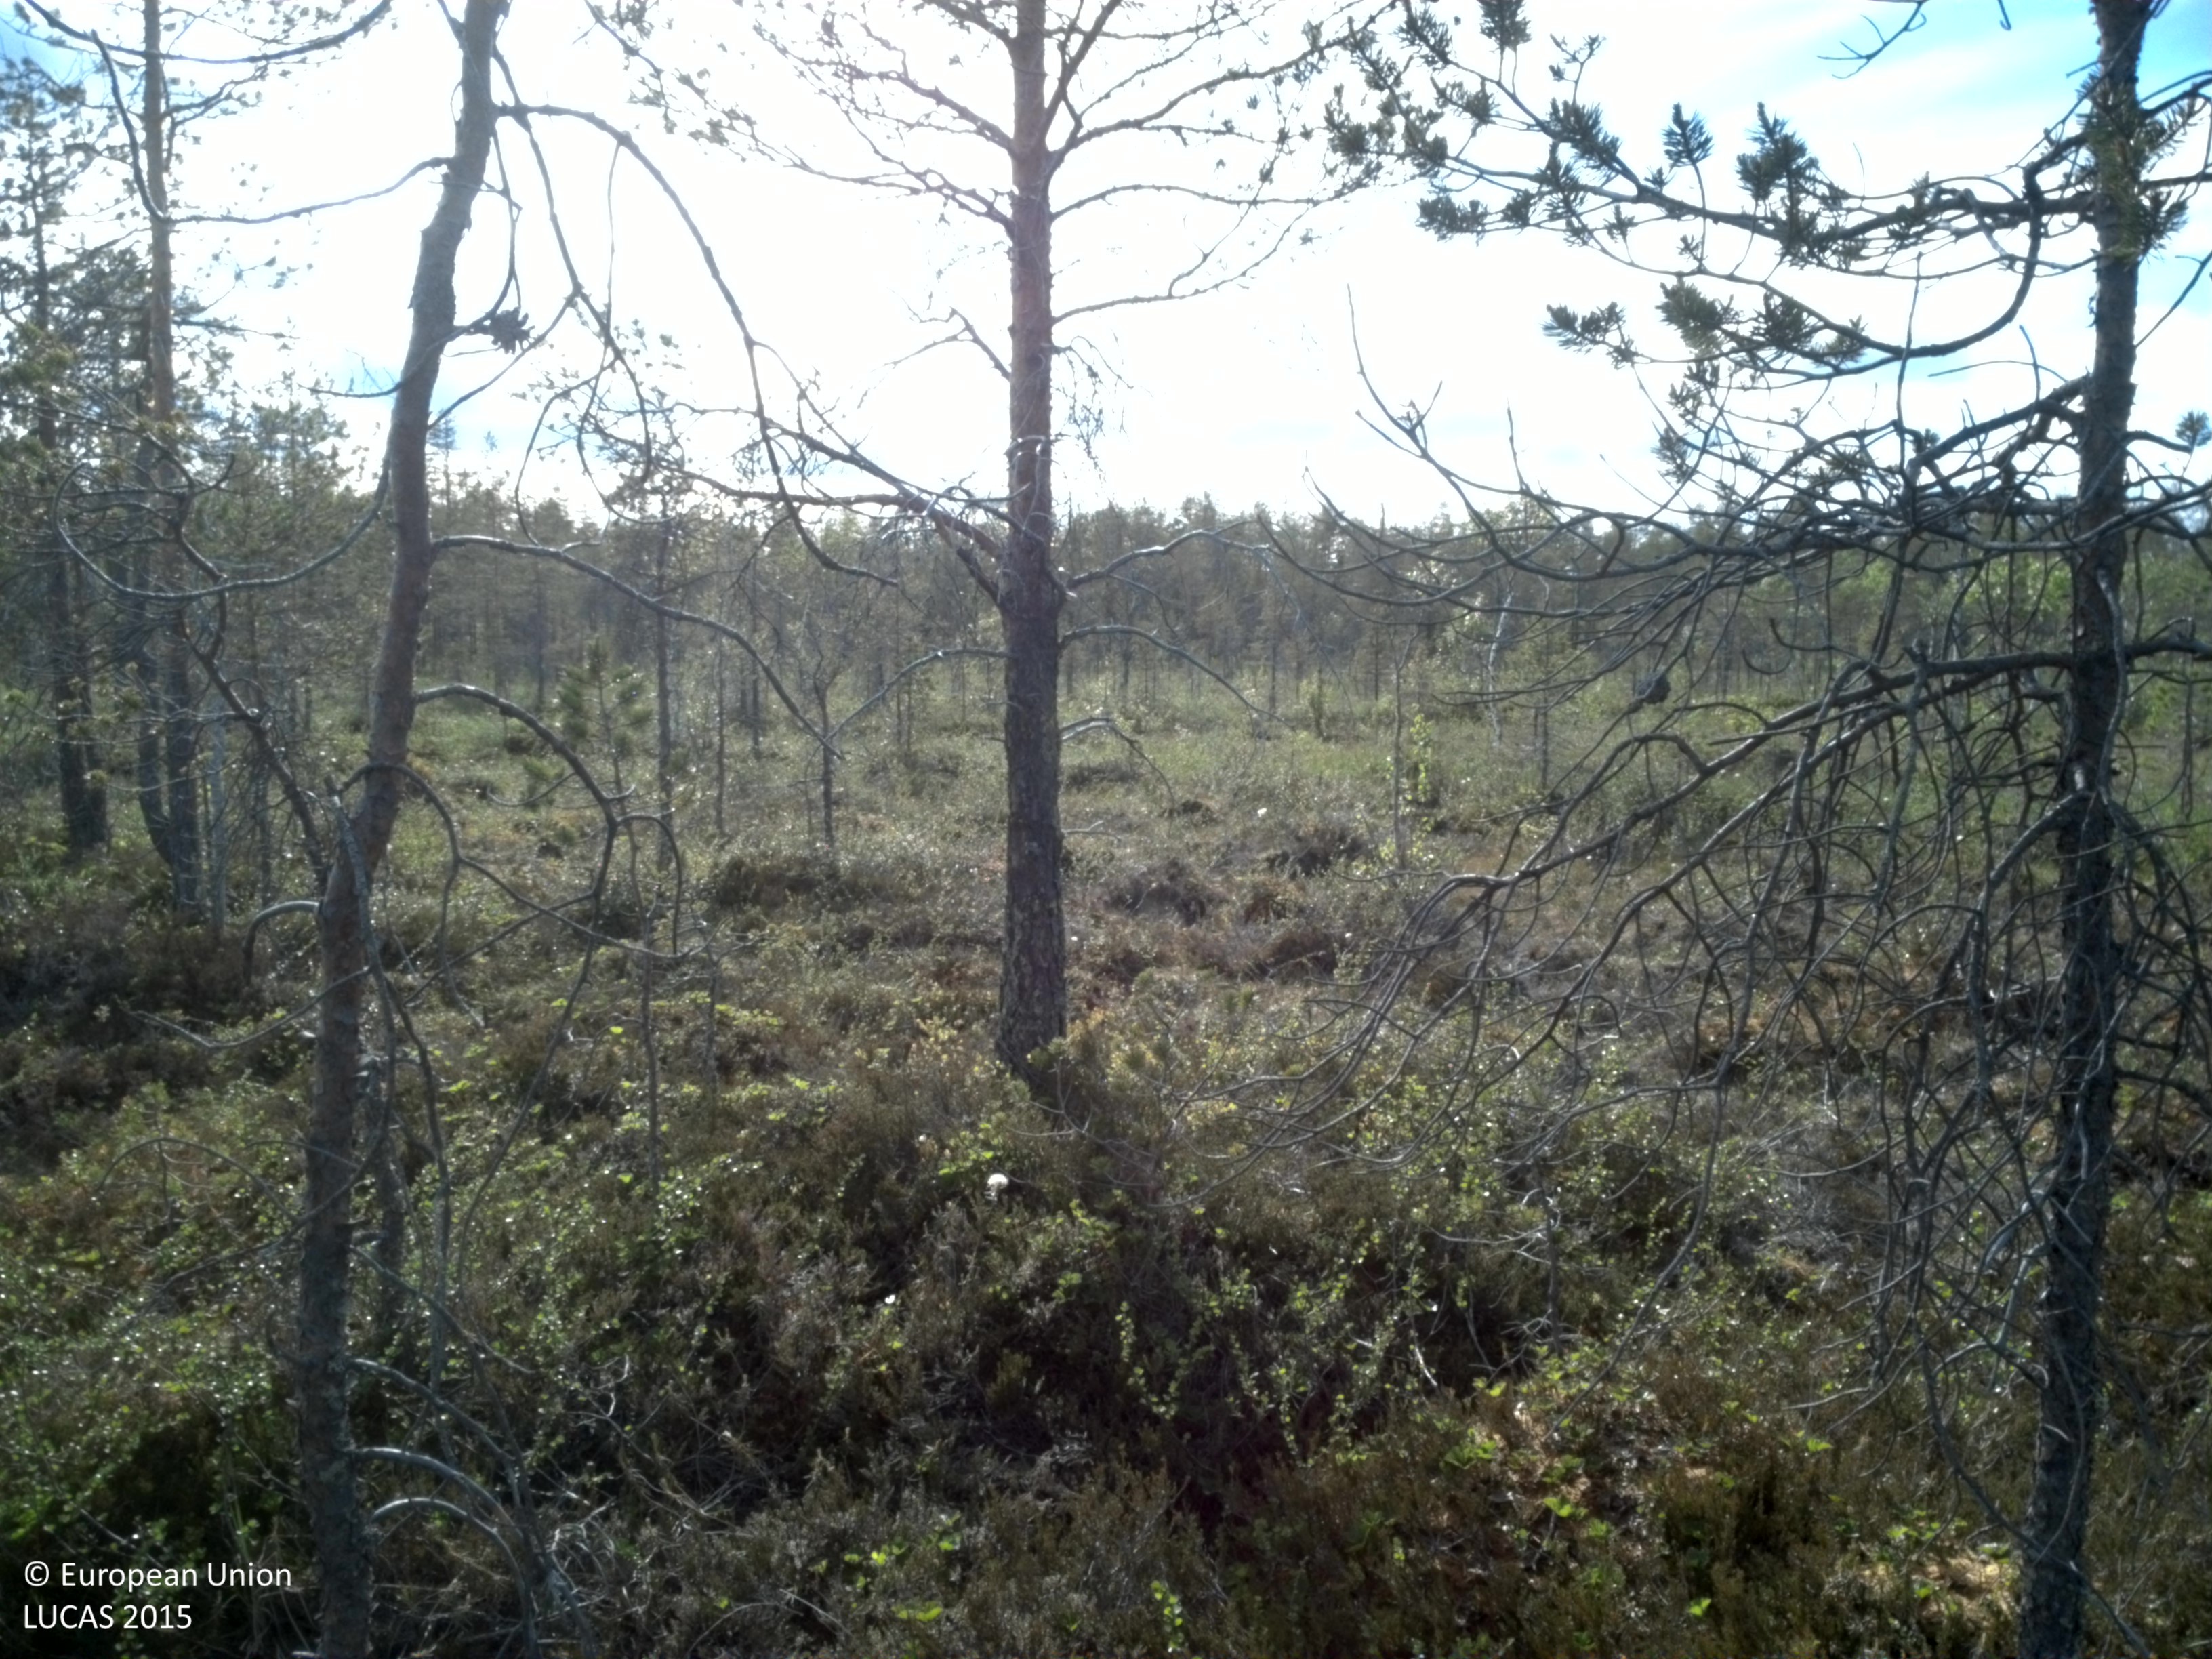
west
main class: Woodland
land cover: Pine dominated coniferous woodland
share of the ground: 10 - 25 %
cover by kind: shrubs 85 %, coniferous forest trees 15 %
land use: Semi-natural and natural areas not in use
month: June
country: SE
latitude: 66.2731
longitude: 22.6940
